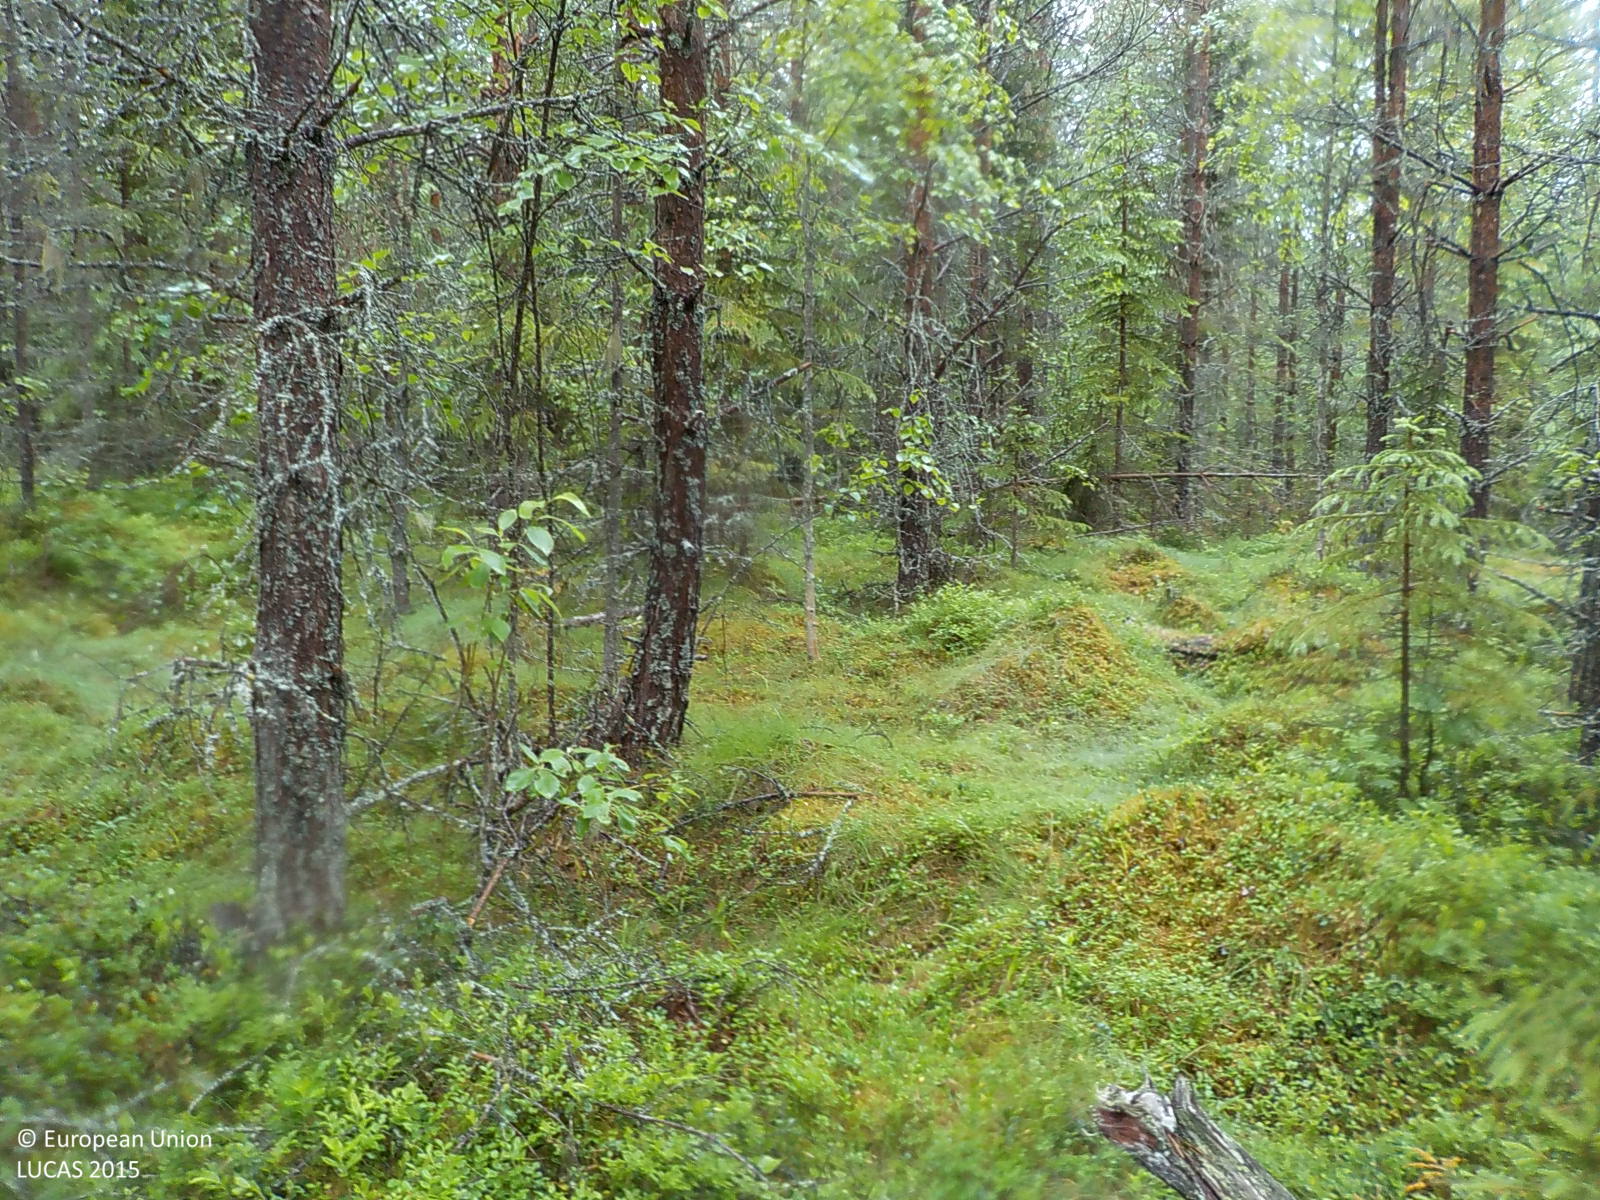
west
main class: Woodland
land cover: Pine dominated coniferous woodland
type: boreal forest
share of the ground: > 75 %
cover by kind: coniferous forest trees 75 %, lichens and mosses 15 %, shrubs 5 %, herbaceous plants 5 %
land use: Forestry
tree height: > 5 m
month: July
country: SE
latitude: 63.0151
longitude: 16.9101
